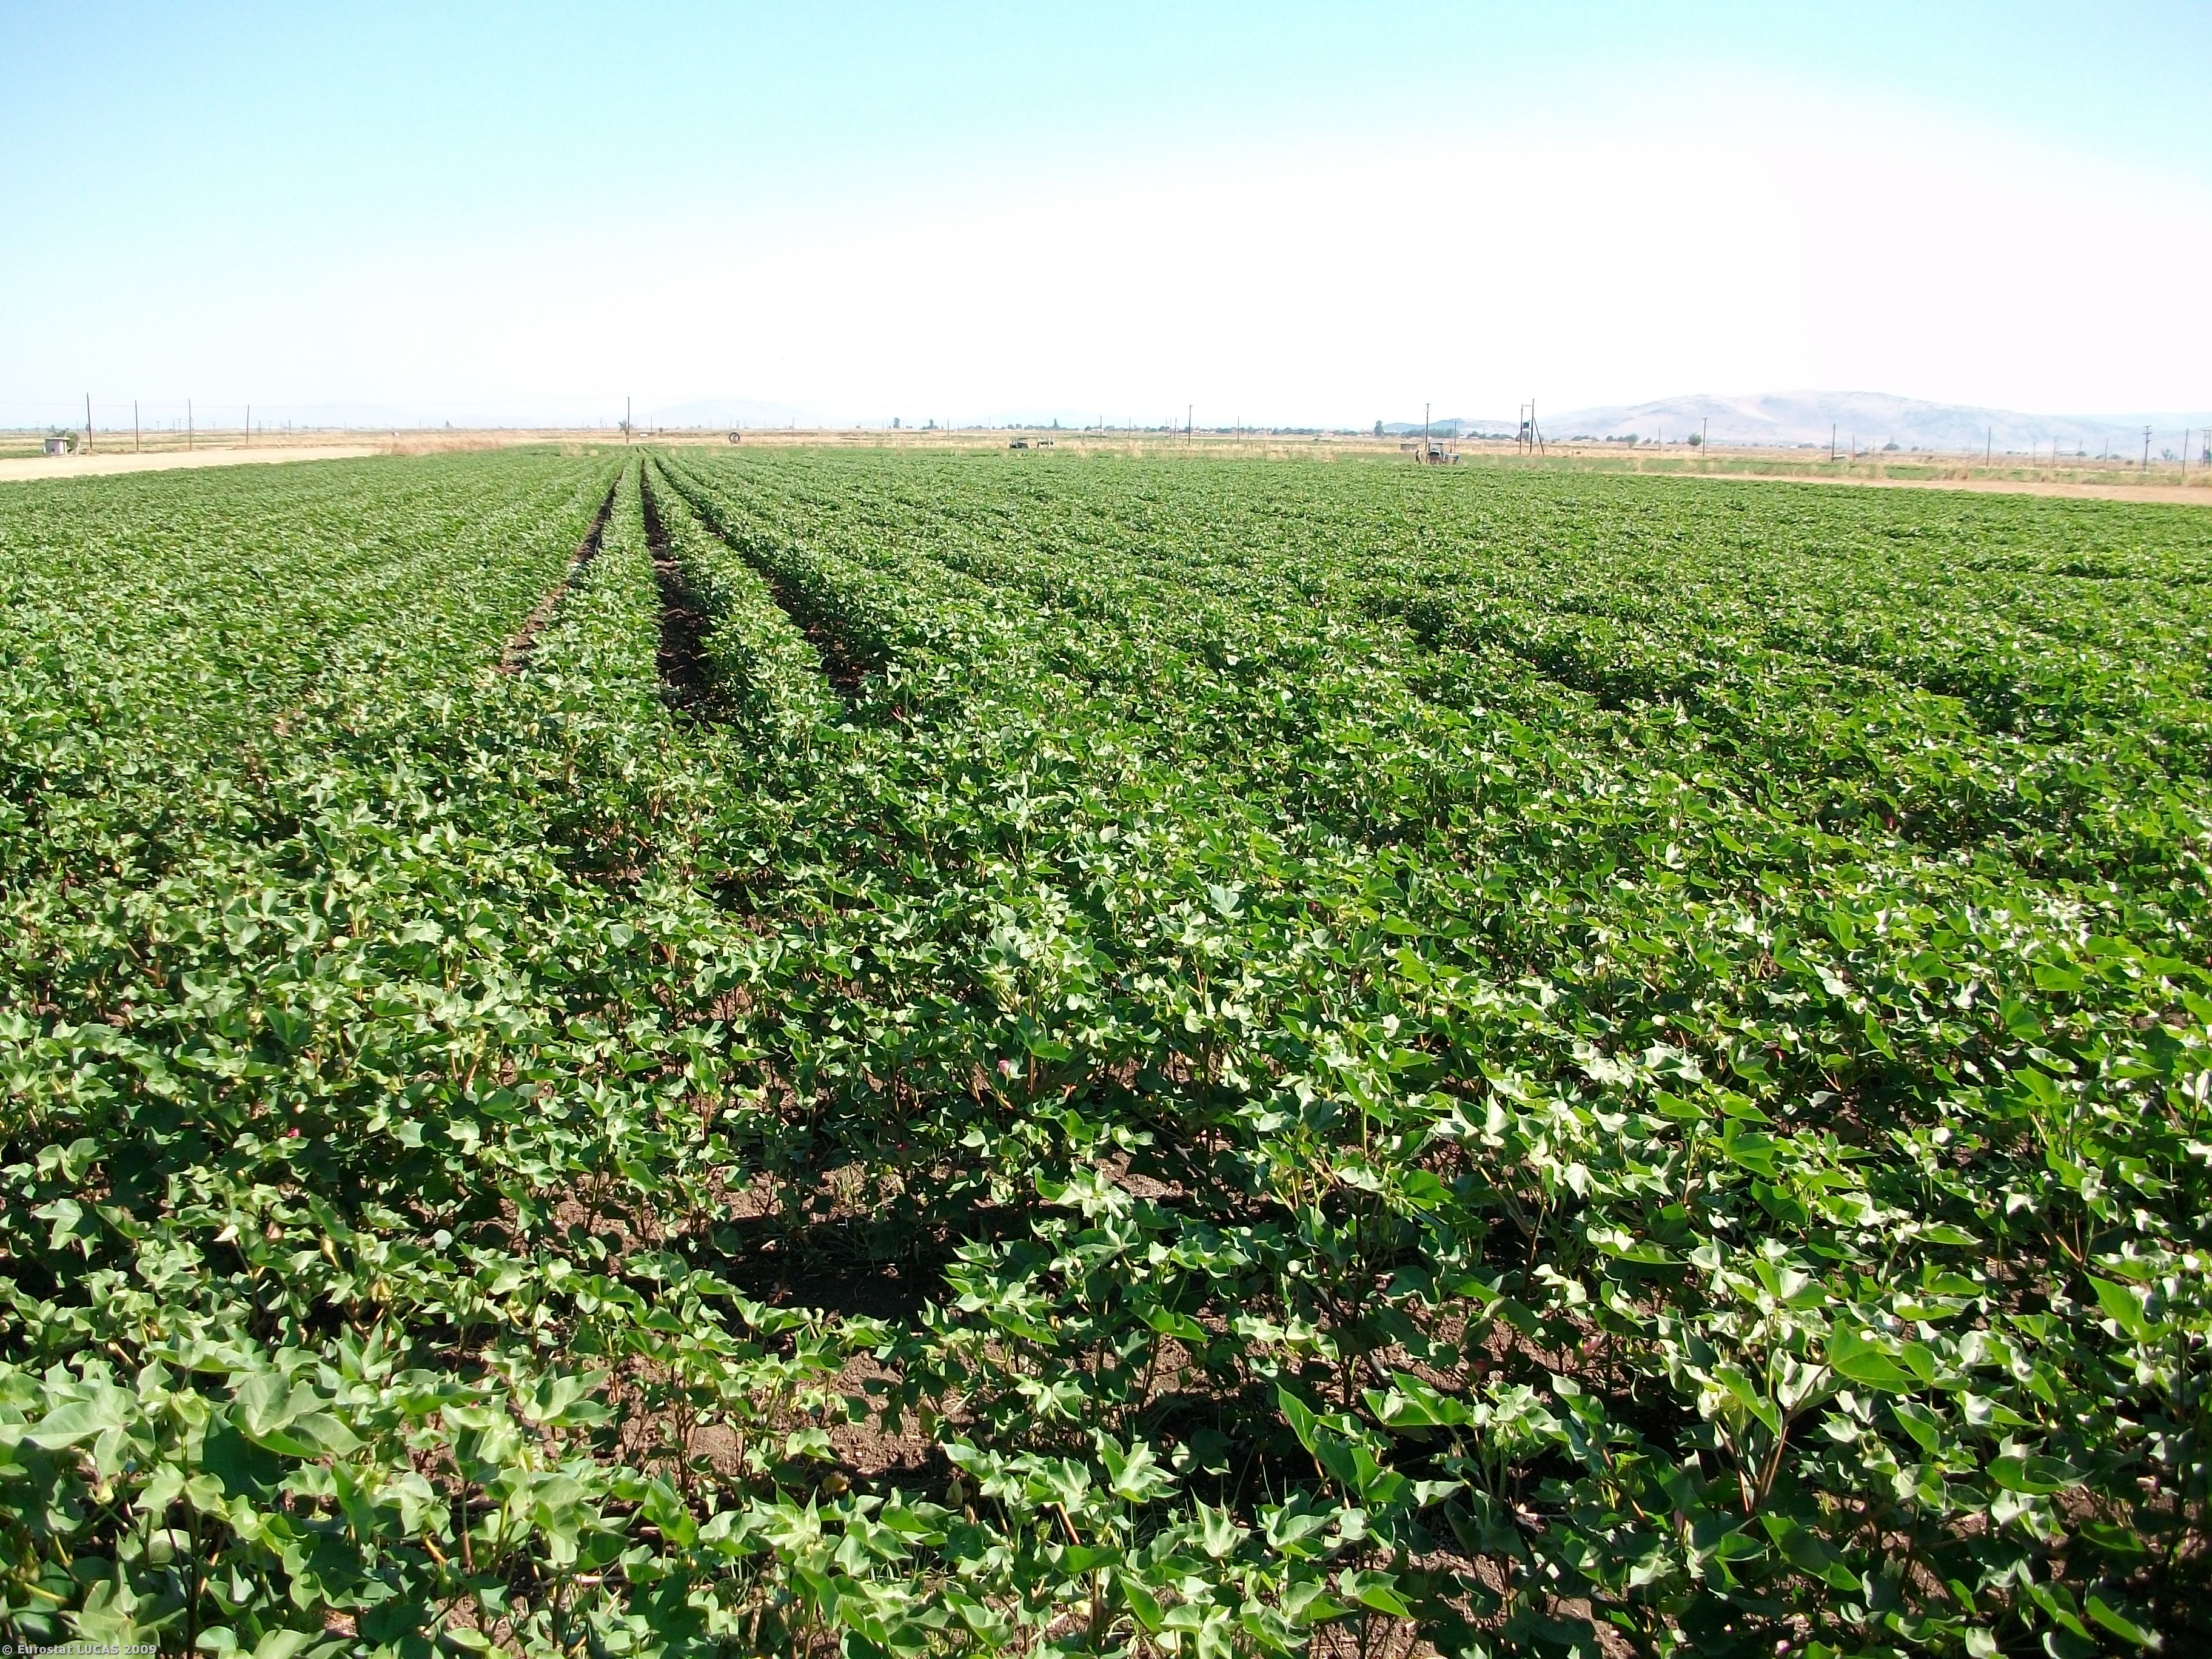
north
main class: Cropland
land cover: Cotton
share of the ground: 50 - 75 %
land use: Agriculture (excluding fallow land and kitchen gardens)
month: July
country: GR
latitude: 39.1688
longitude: 22.2396
